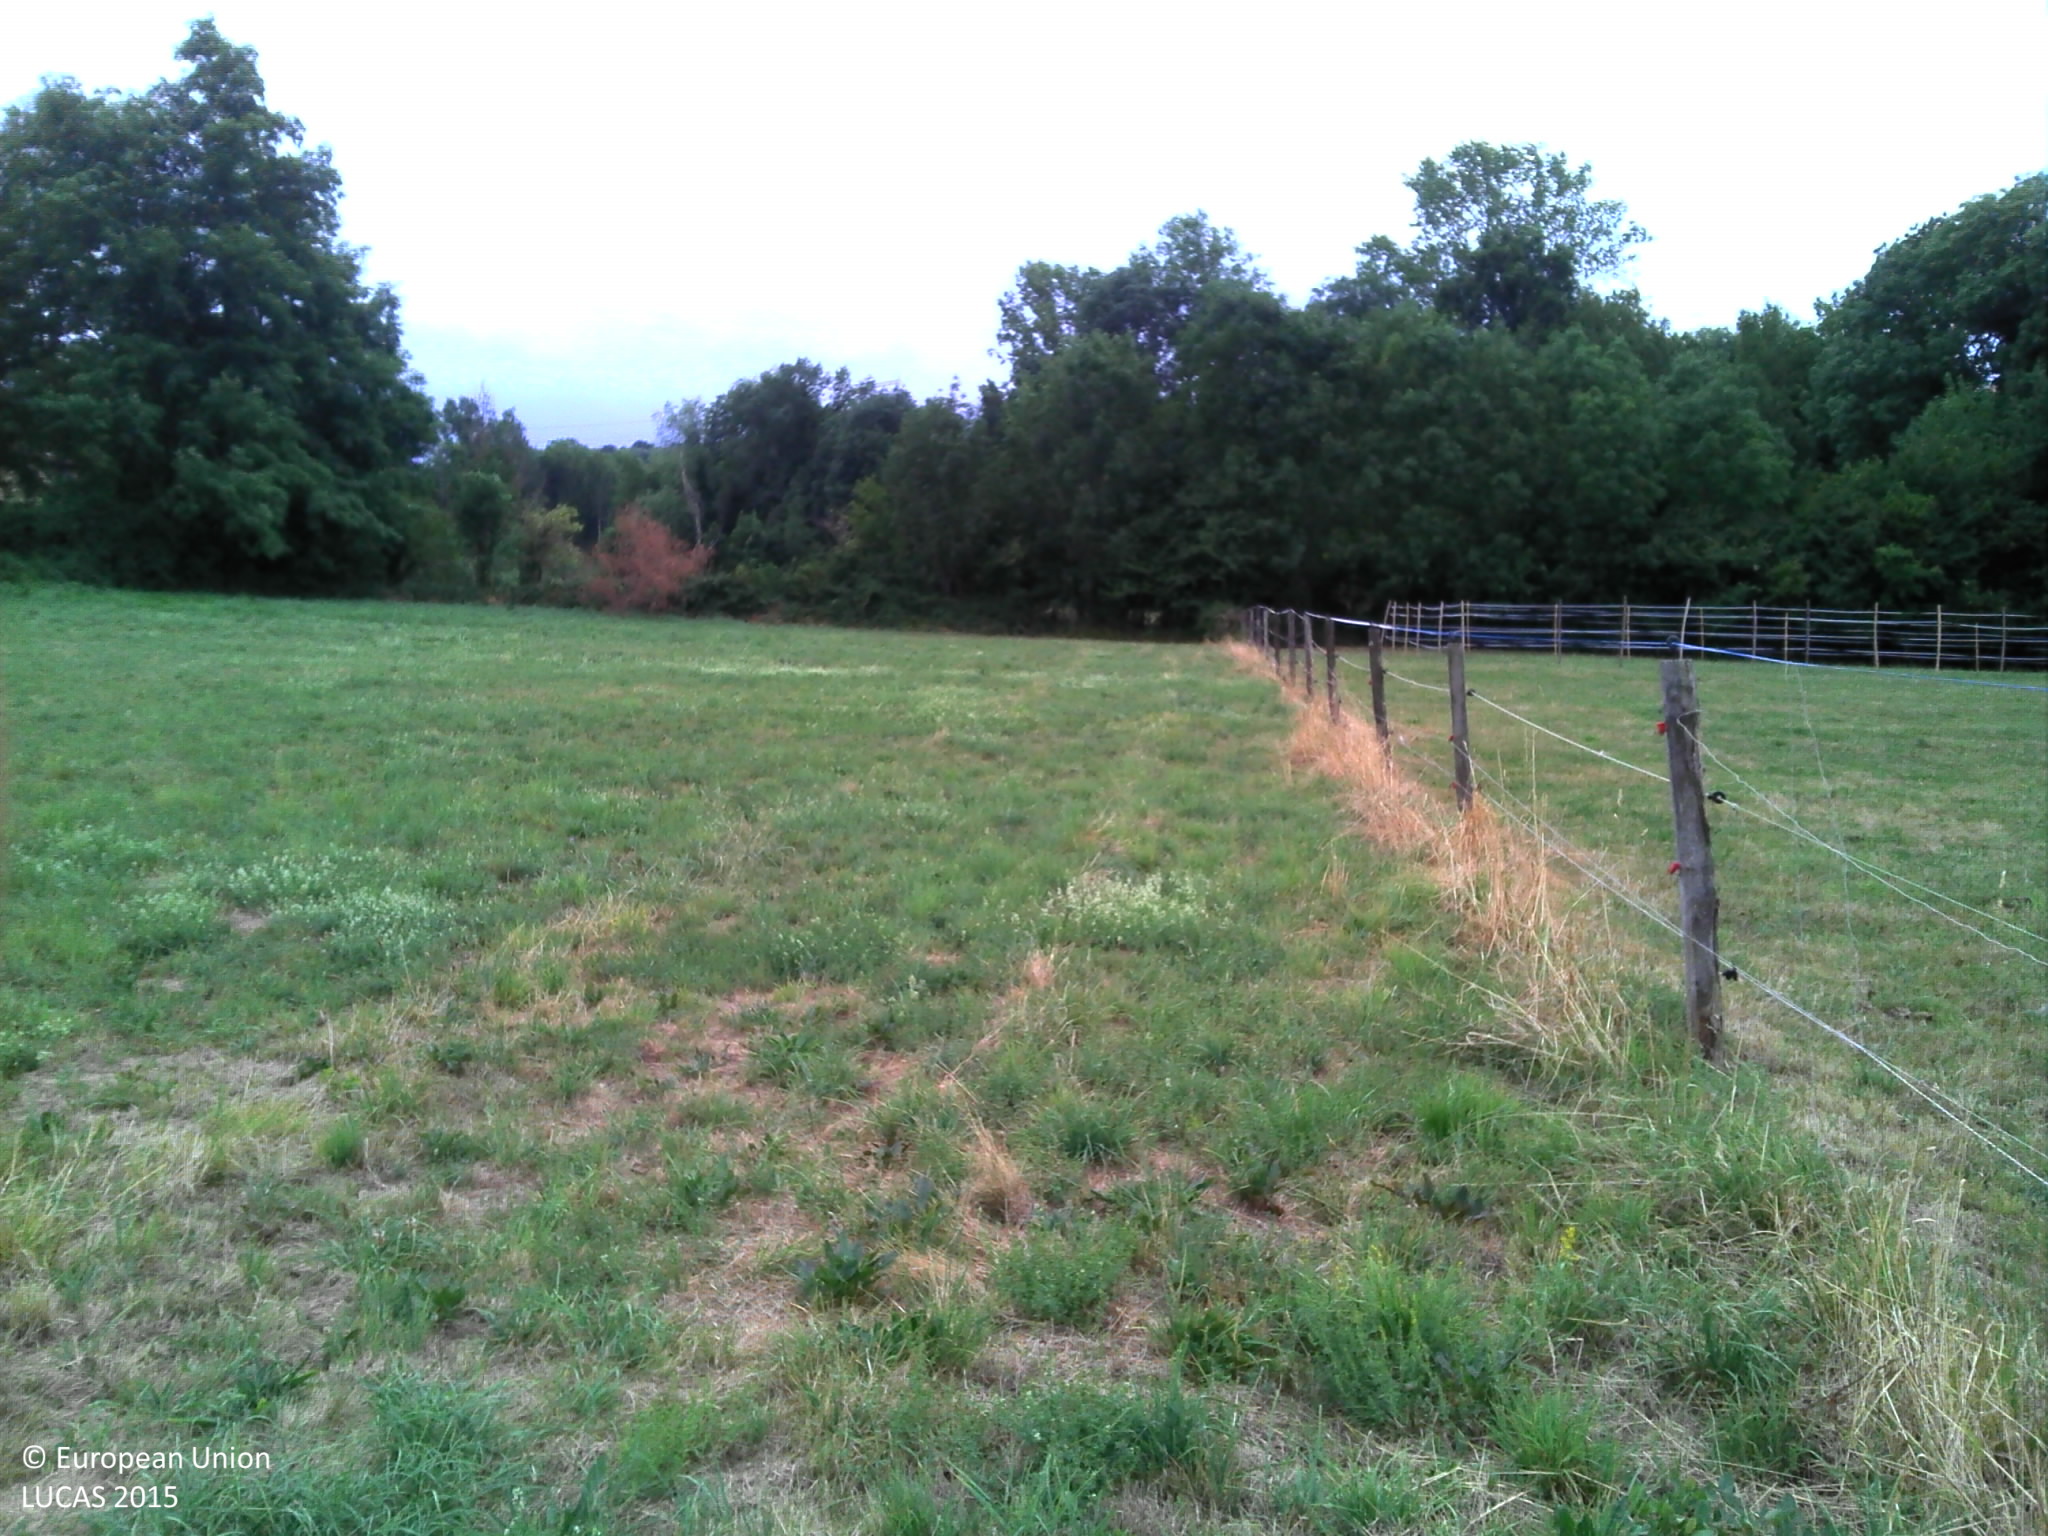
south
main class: Grassland
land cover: Grassland without tree/shrub cover
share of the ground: > 75 %
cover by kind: herbaceous plants 100 %
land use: Agriculture (excluding fallow land and kitchen gardens)
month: July
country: FR
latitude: 45.4751
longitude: 4.9771
